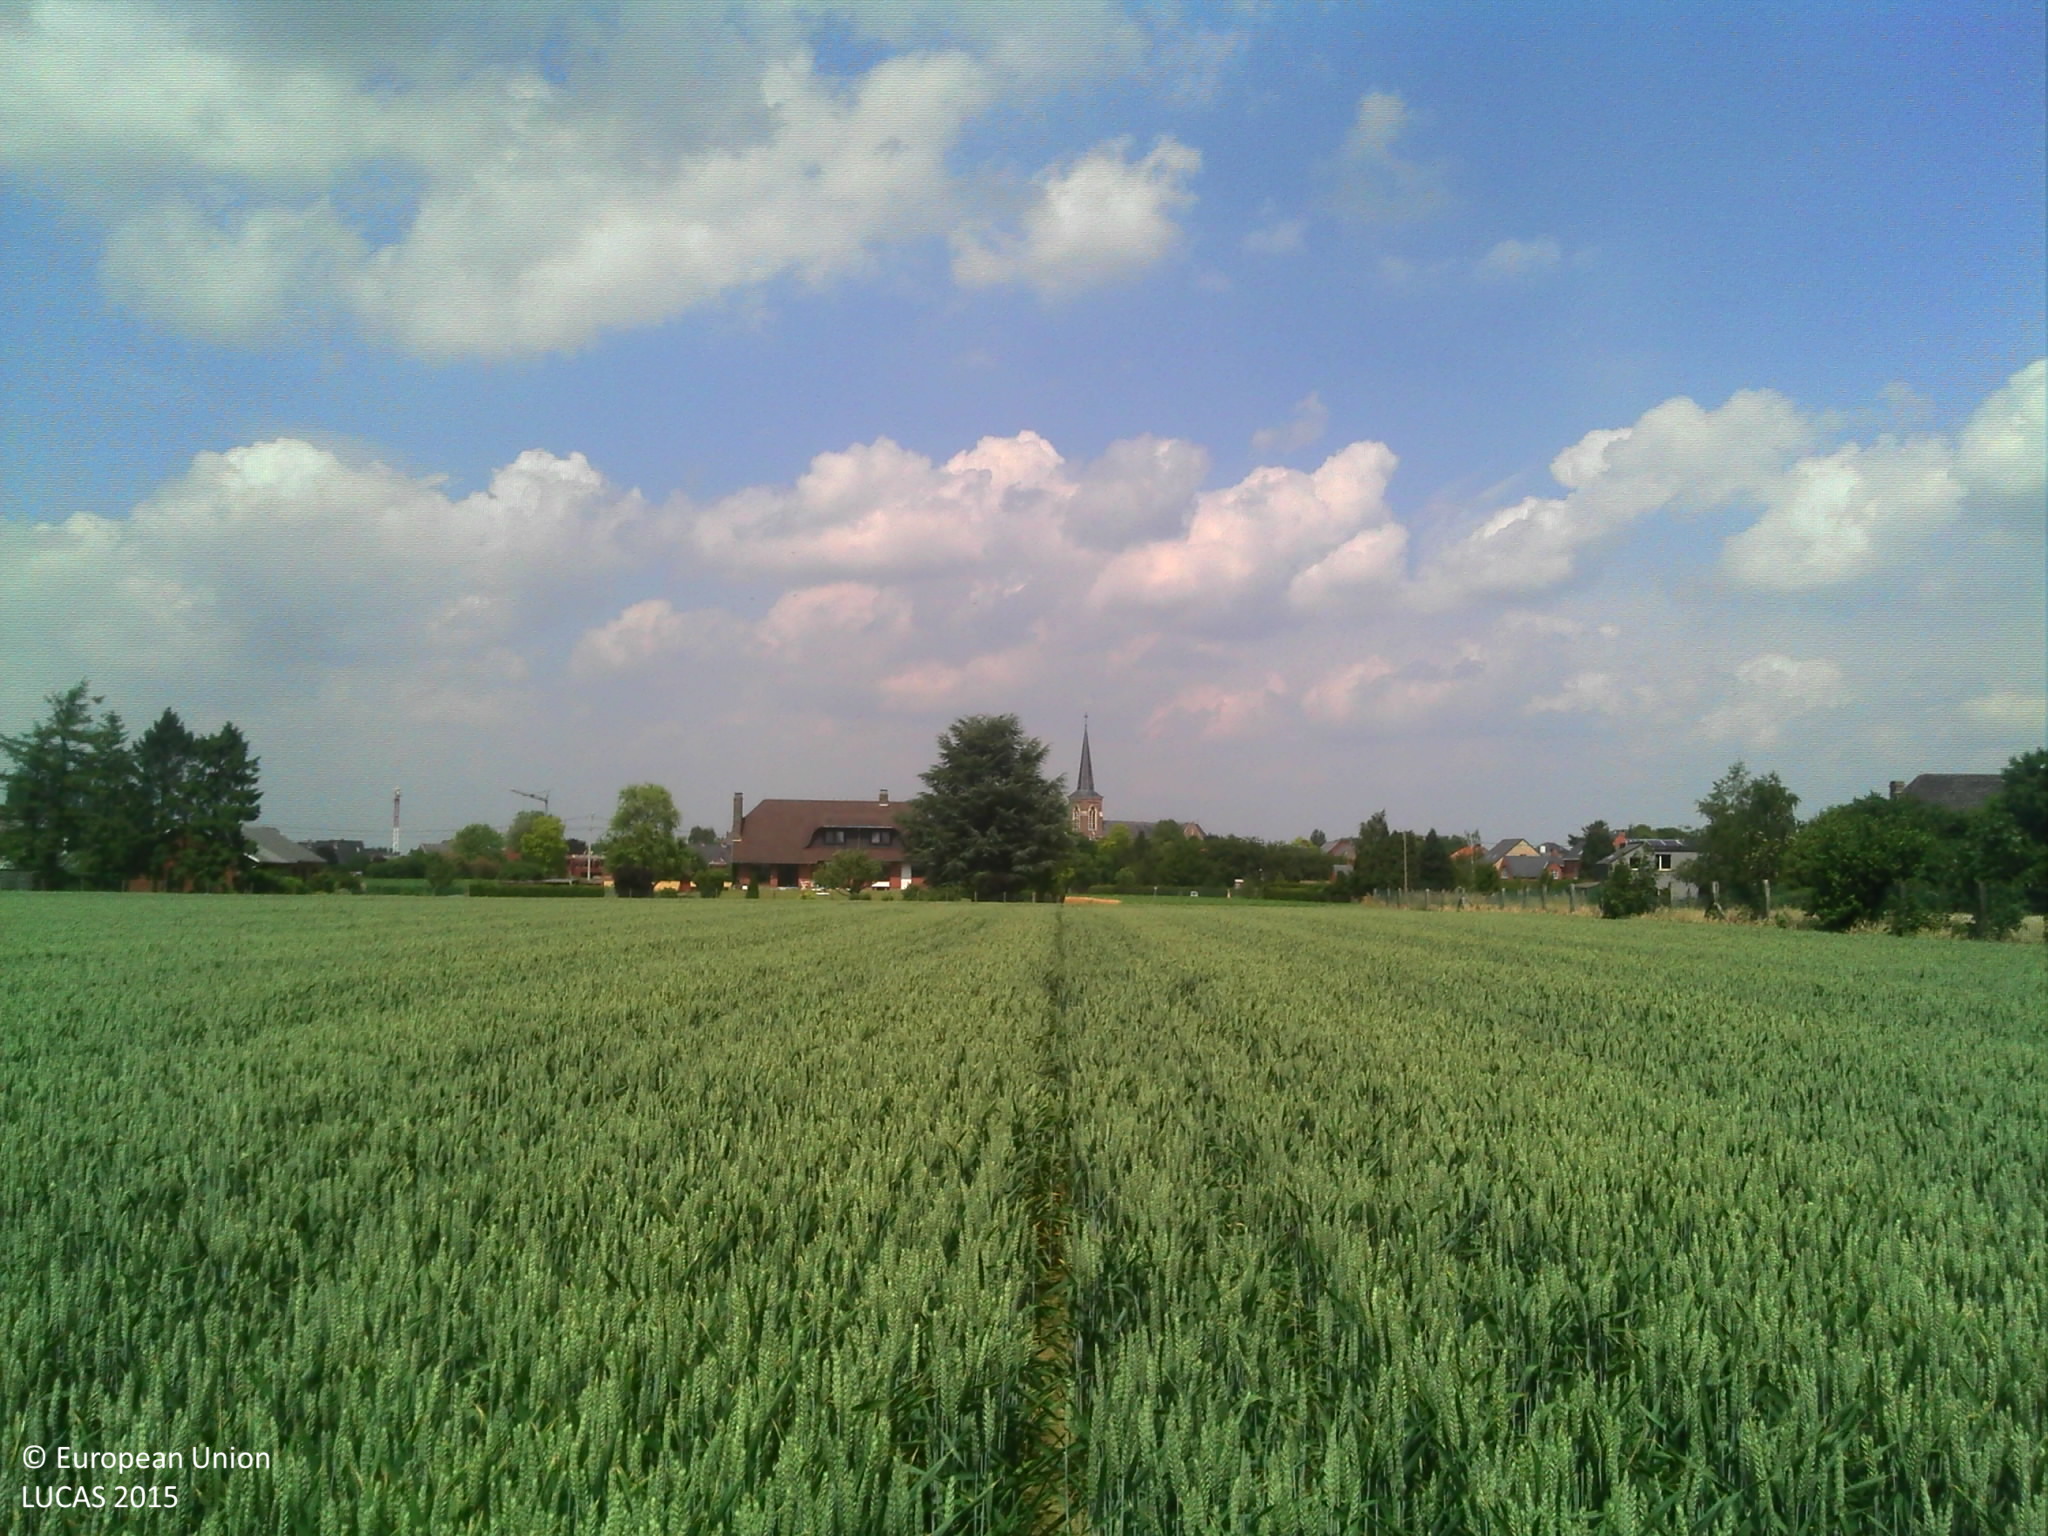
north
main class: Cropland
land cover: Common wheat
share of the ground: > 75 %
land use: Agriculture (excluding fallow land and kitchen gardens)
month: June
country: BE
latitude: 50.9368
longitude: 4.5457
